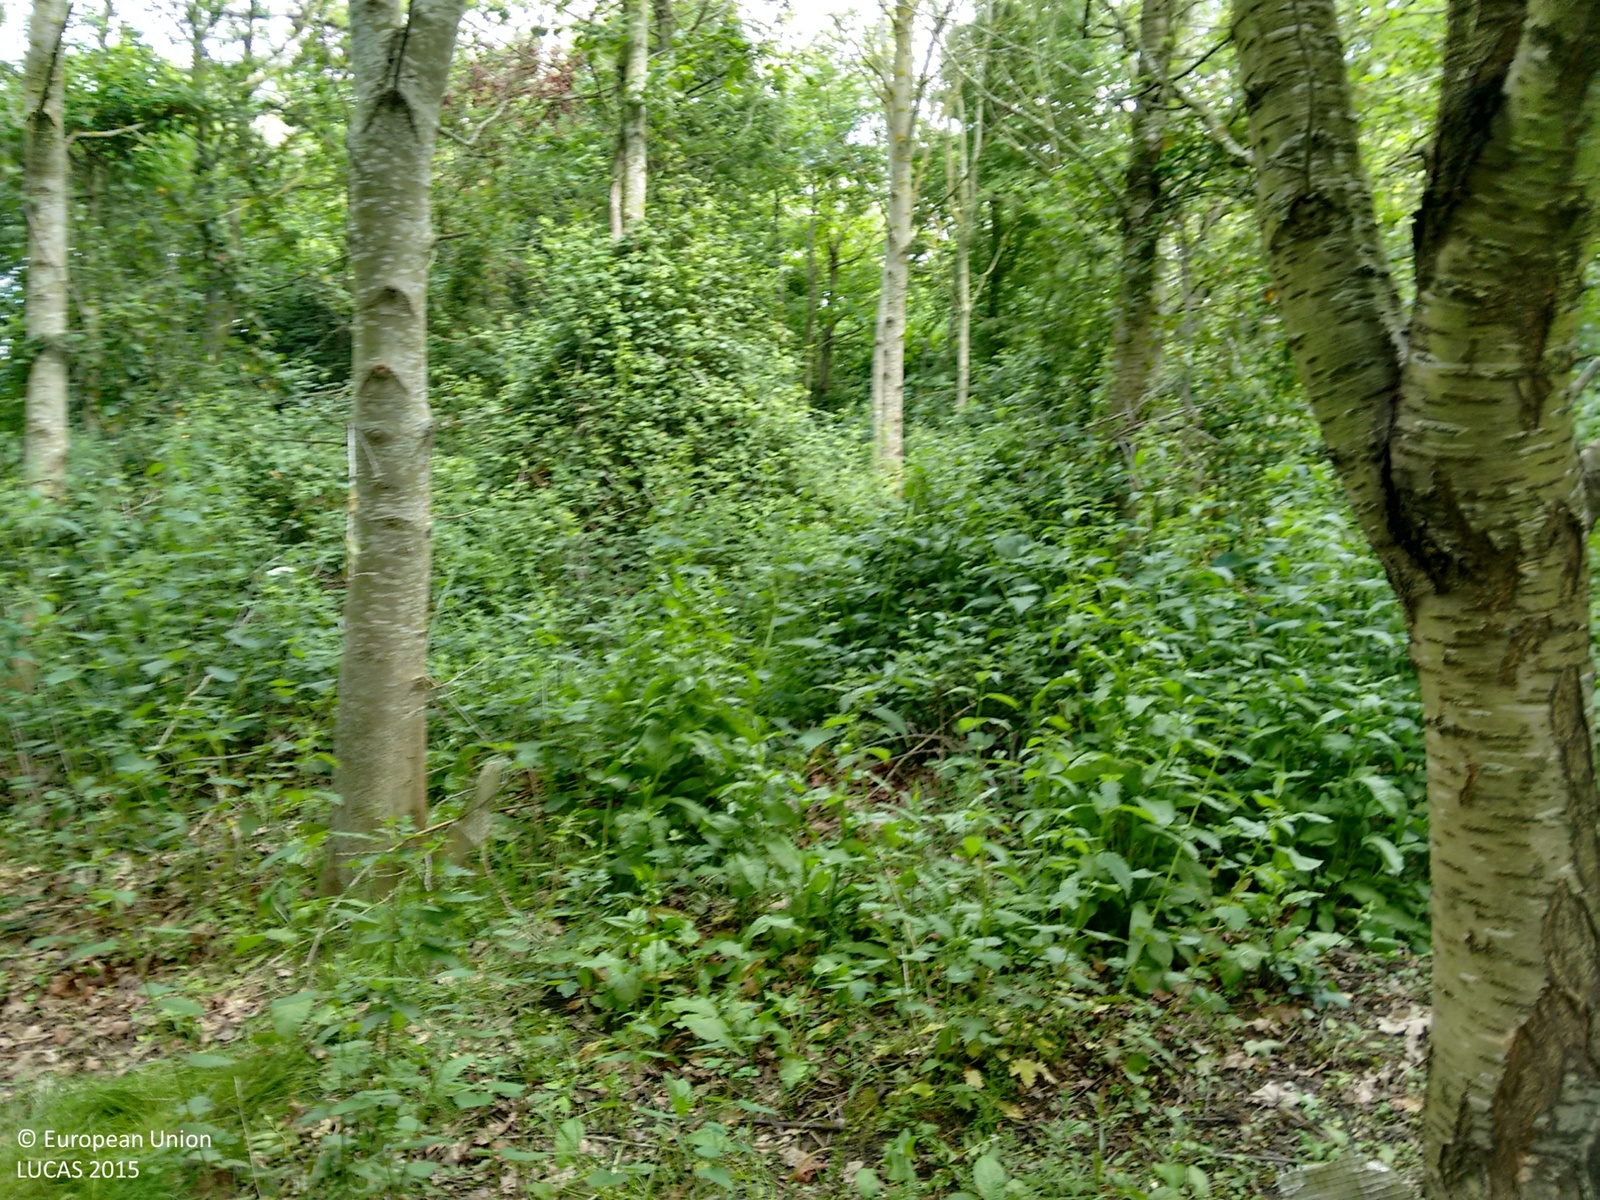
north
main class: Woodland
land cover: Broadleaved woodland
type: mesophytic deciduous forest
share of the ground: > 75 %
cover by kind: broadleaved forest trees 95 %, shrubs 5 %
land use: Forestry
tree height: > 5 m
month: June
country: GB
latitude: 52.0591
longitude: -1.6187
